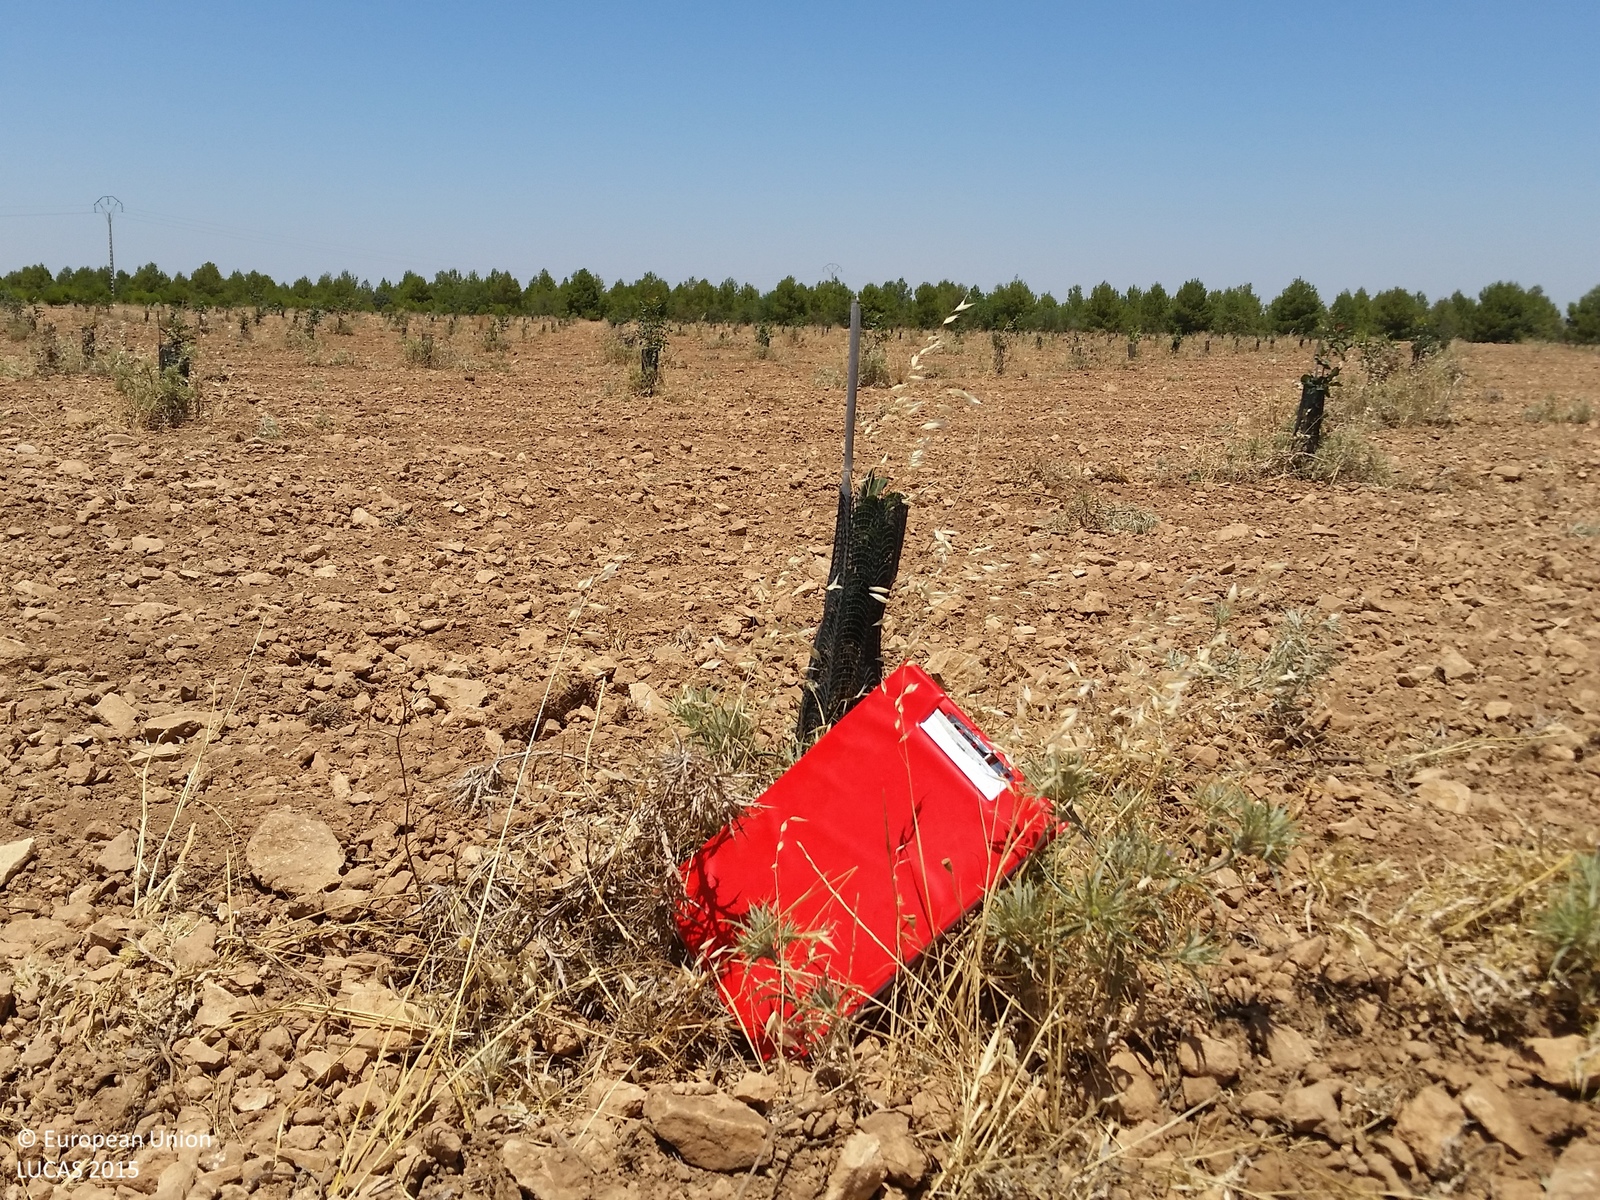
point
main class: Cropland
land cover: Nuts trees
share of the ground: < 10 %
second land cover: Other bare soil
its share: > 75 %
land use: Agriculture (excluding fallow land and kitchen gardens)
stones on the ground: 10 - 25 %
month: July
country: ES
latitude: 39.1276
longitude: -2.5586
